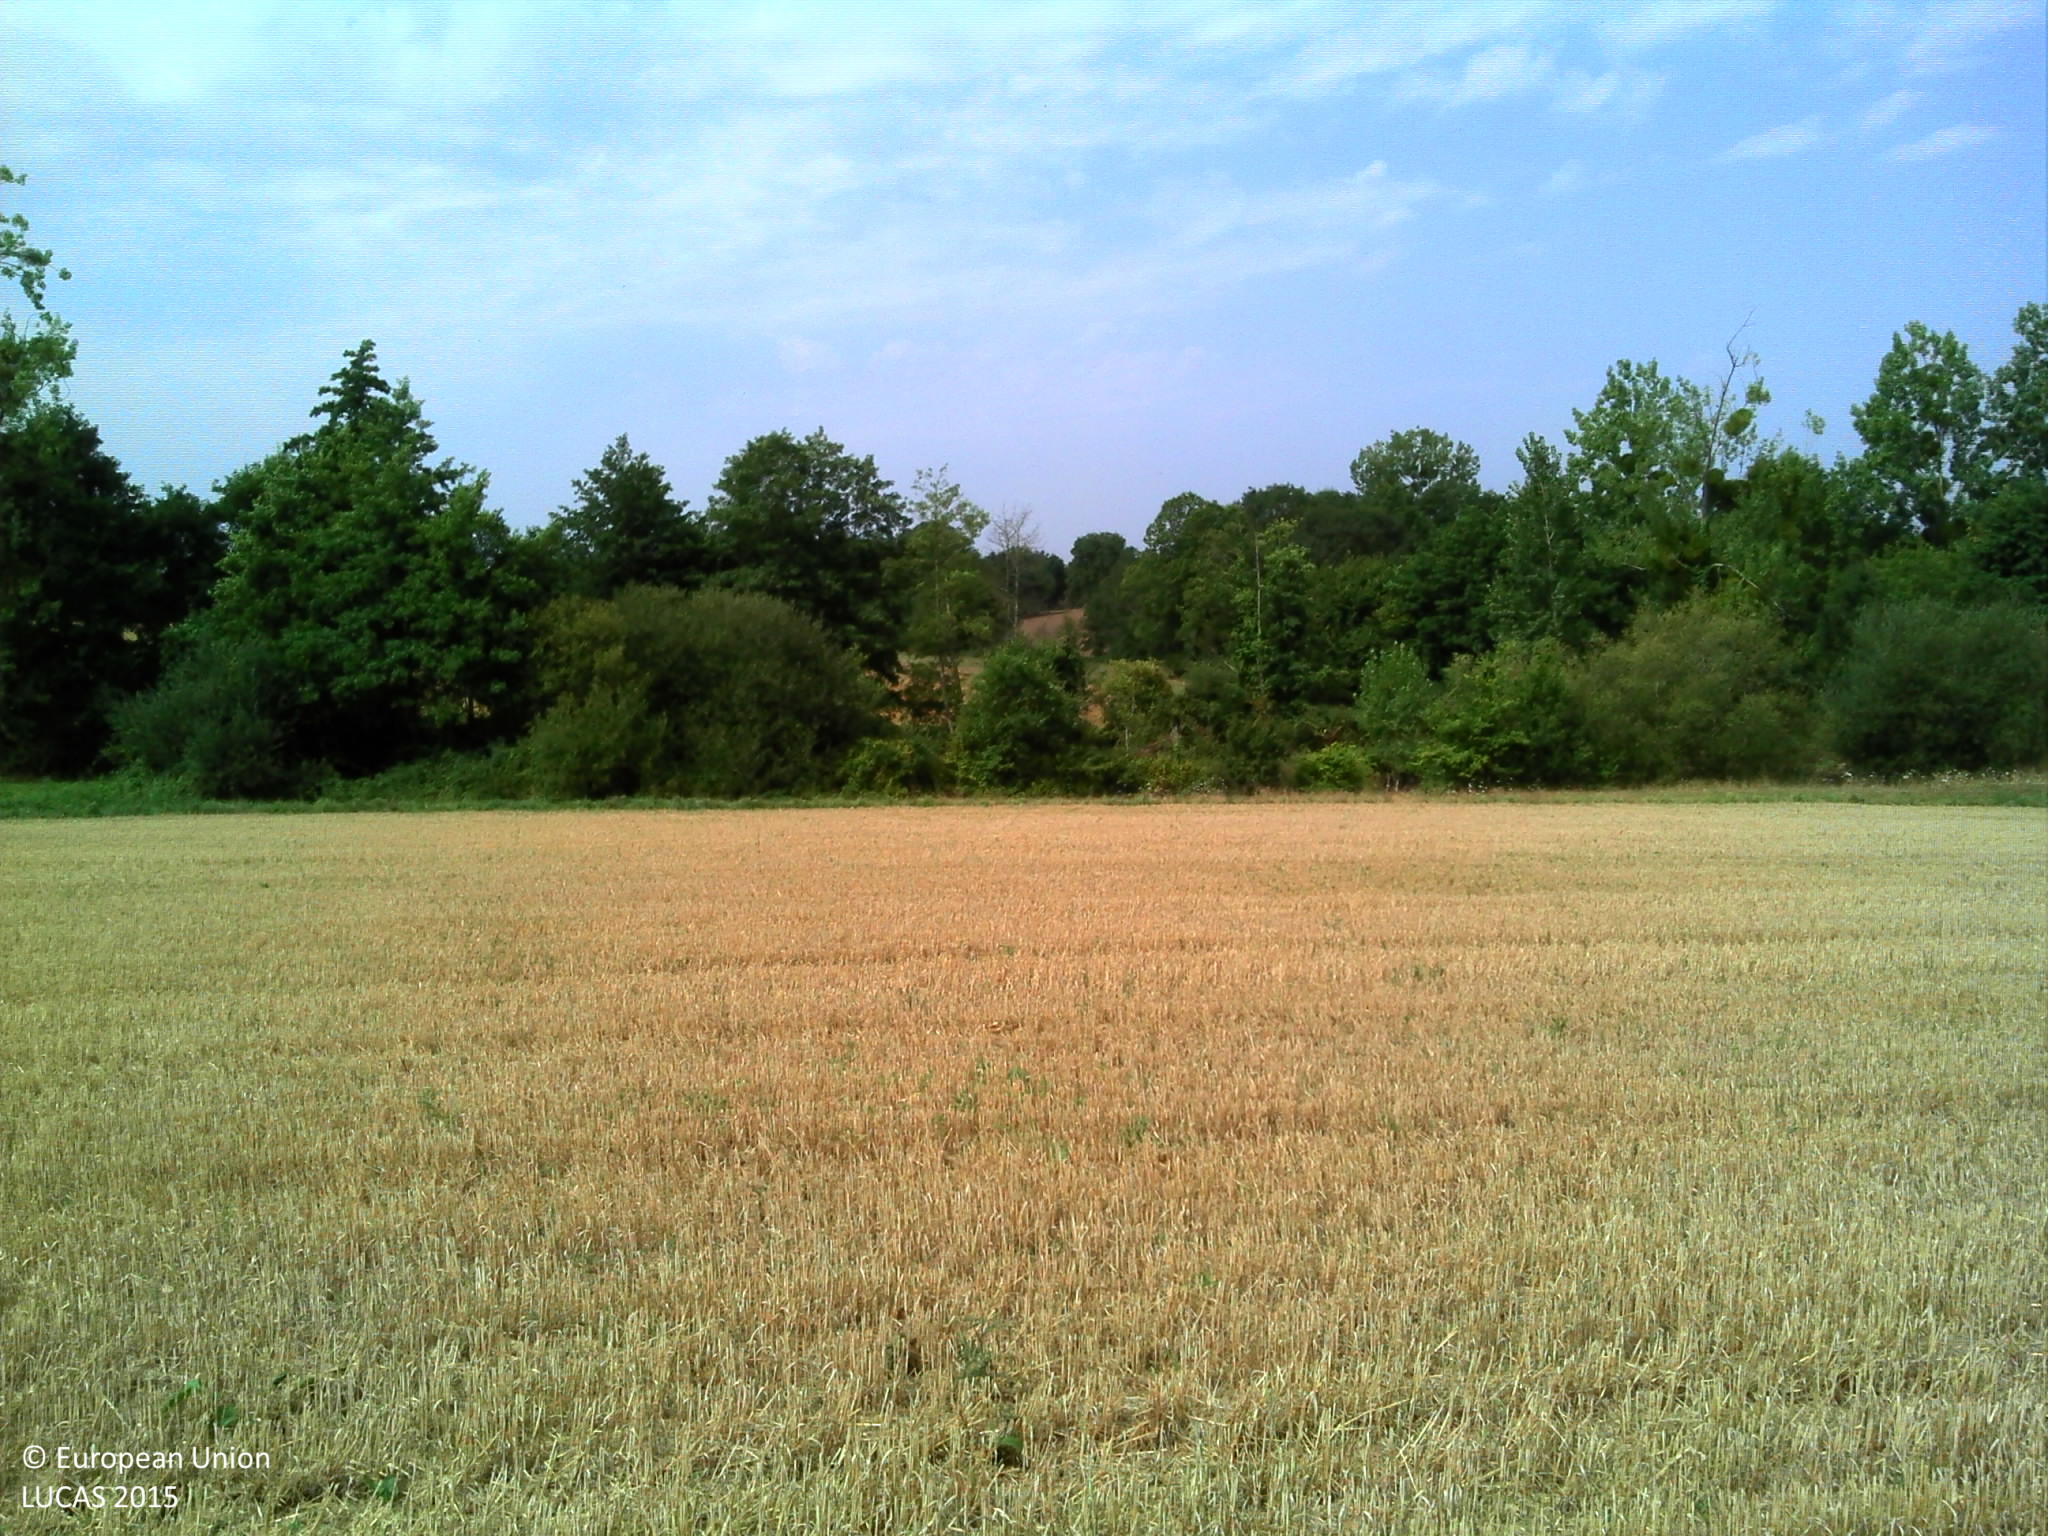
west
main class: Cropland
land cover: Barley
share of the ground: > 75 %
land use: Agriculture (excluding fallow land and kitchen gardens)
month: August
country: FR
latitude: 46.9515
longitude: -1.4576
